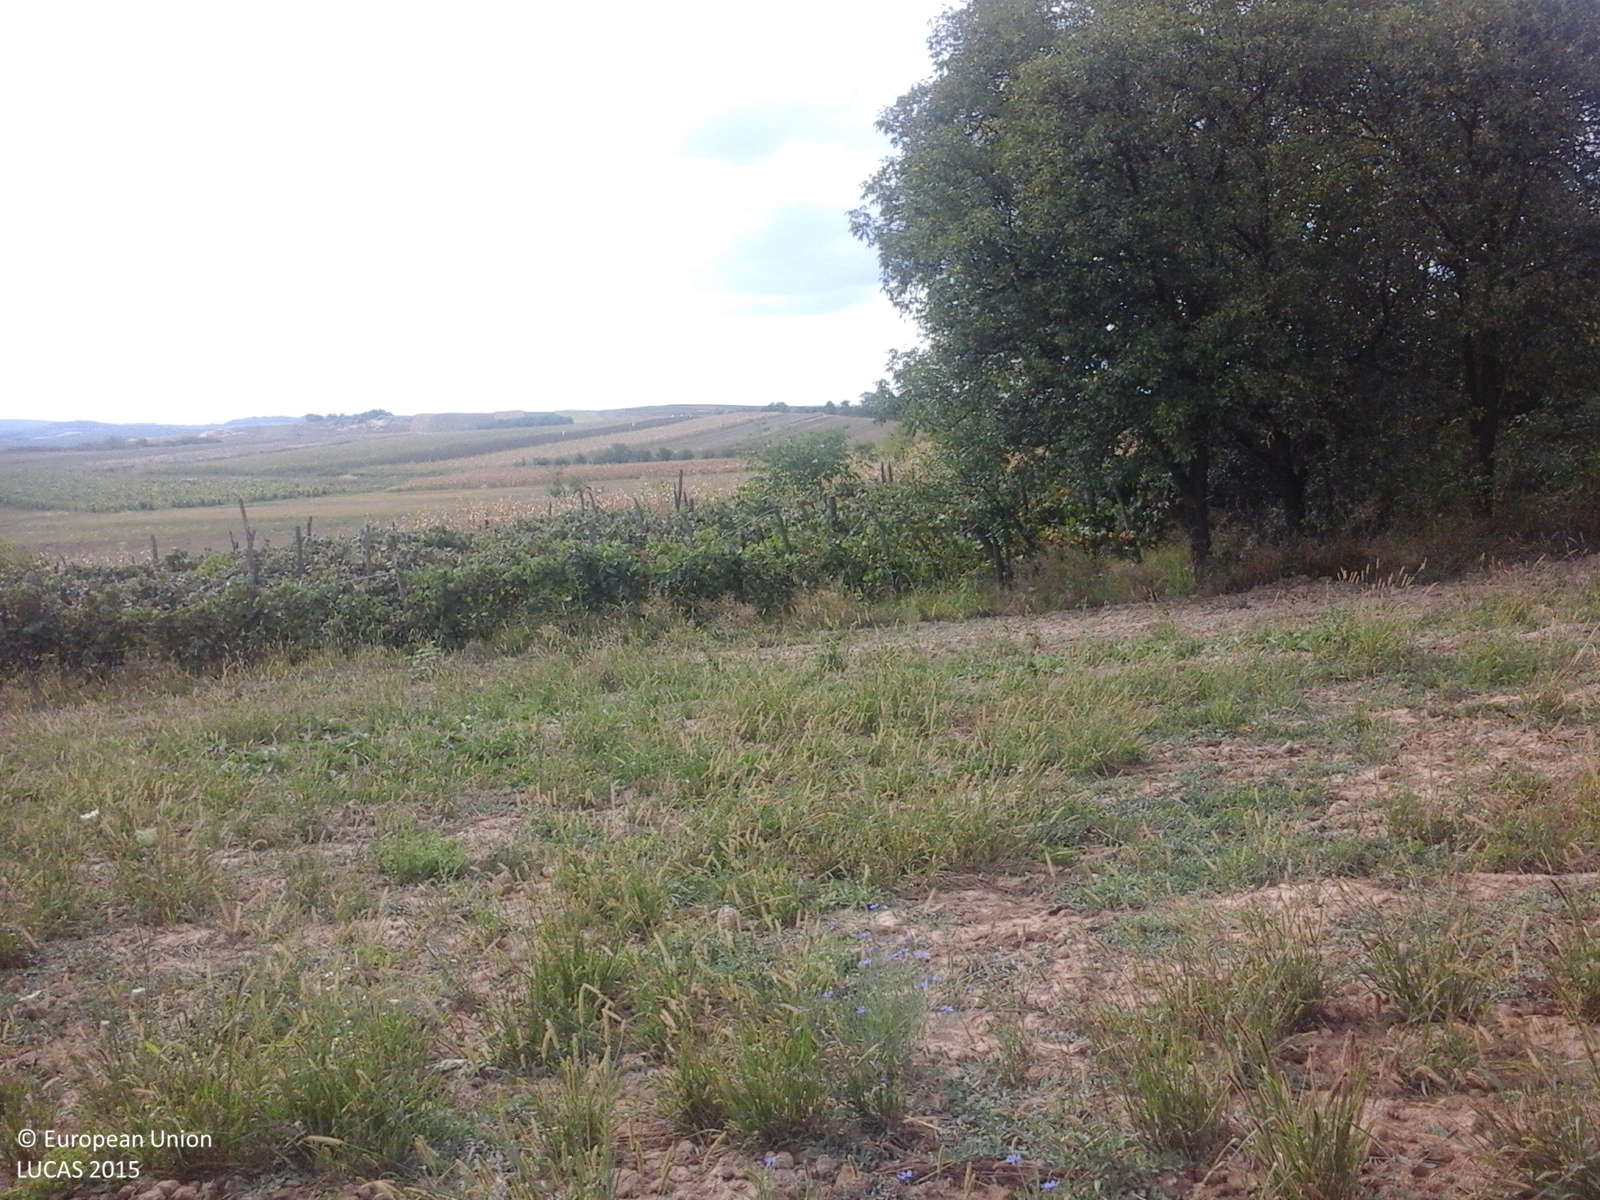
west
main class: Grassland
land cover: Spontaneously vegetated surfaces
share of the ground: > 75 %
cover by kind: herbaceous plants 100 %
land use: Fallow land
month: September
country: RO
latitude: 47.4522
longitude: 23.1313
